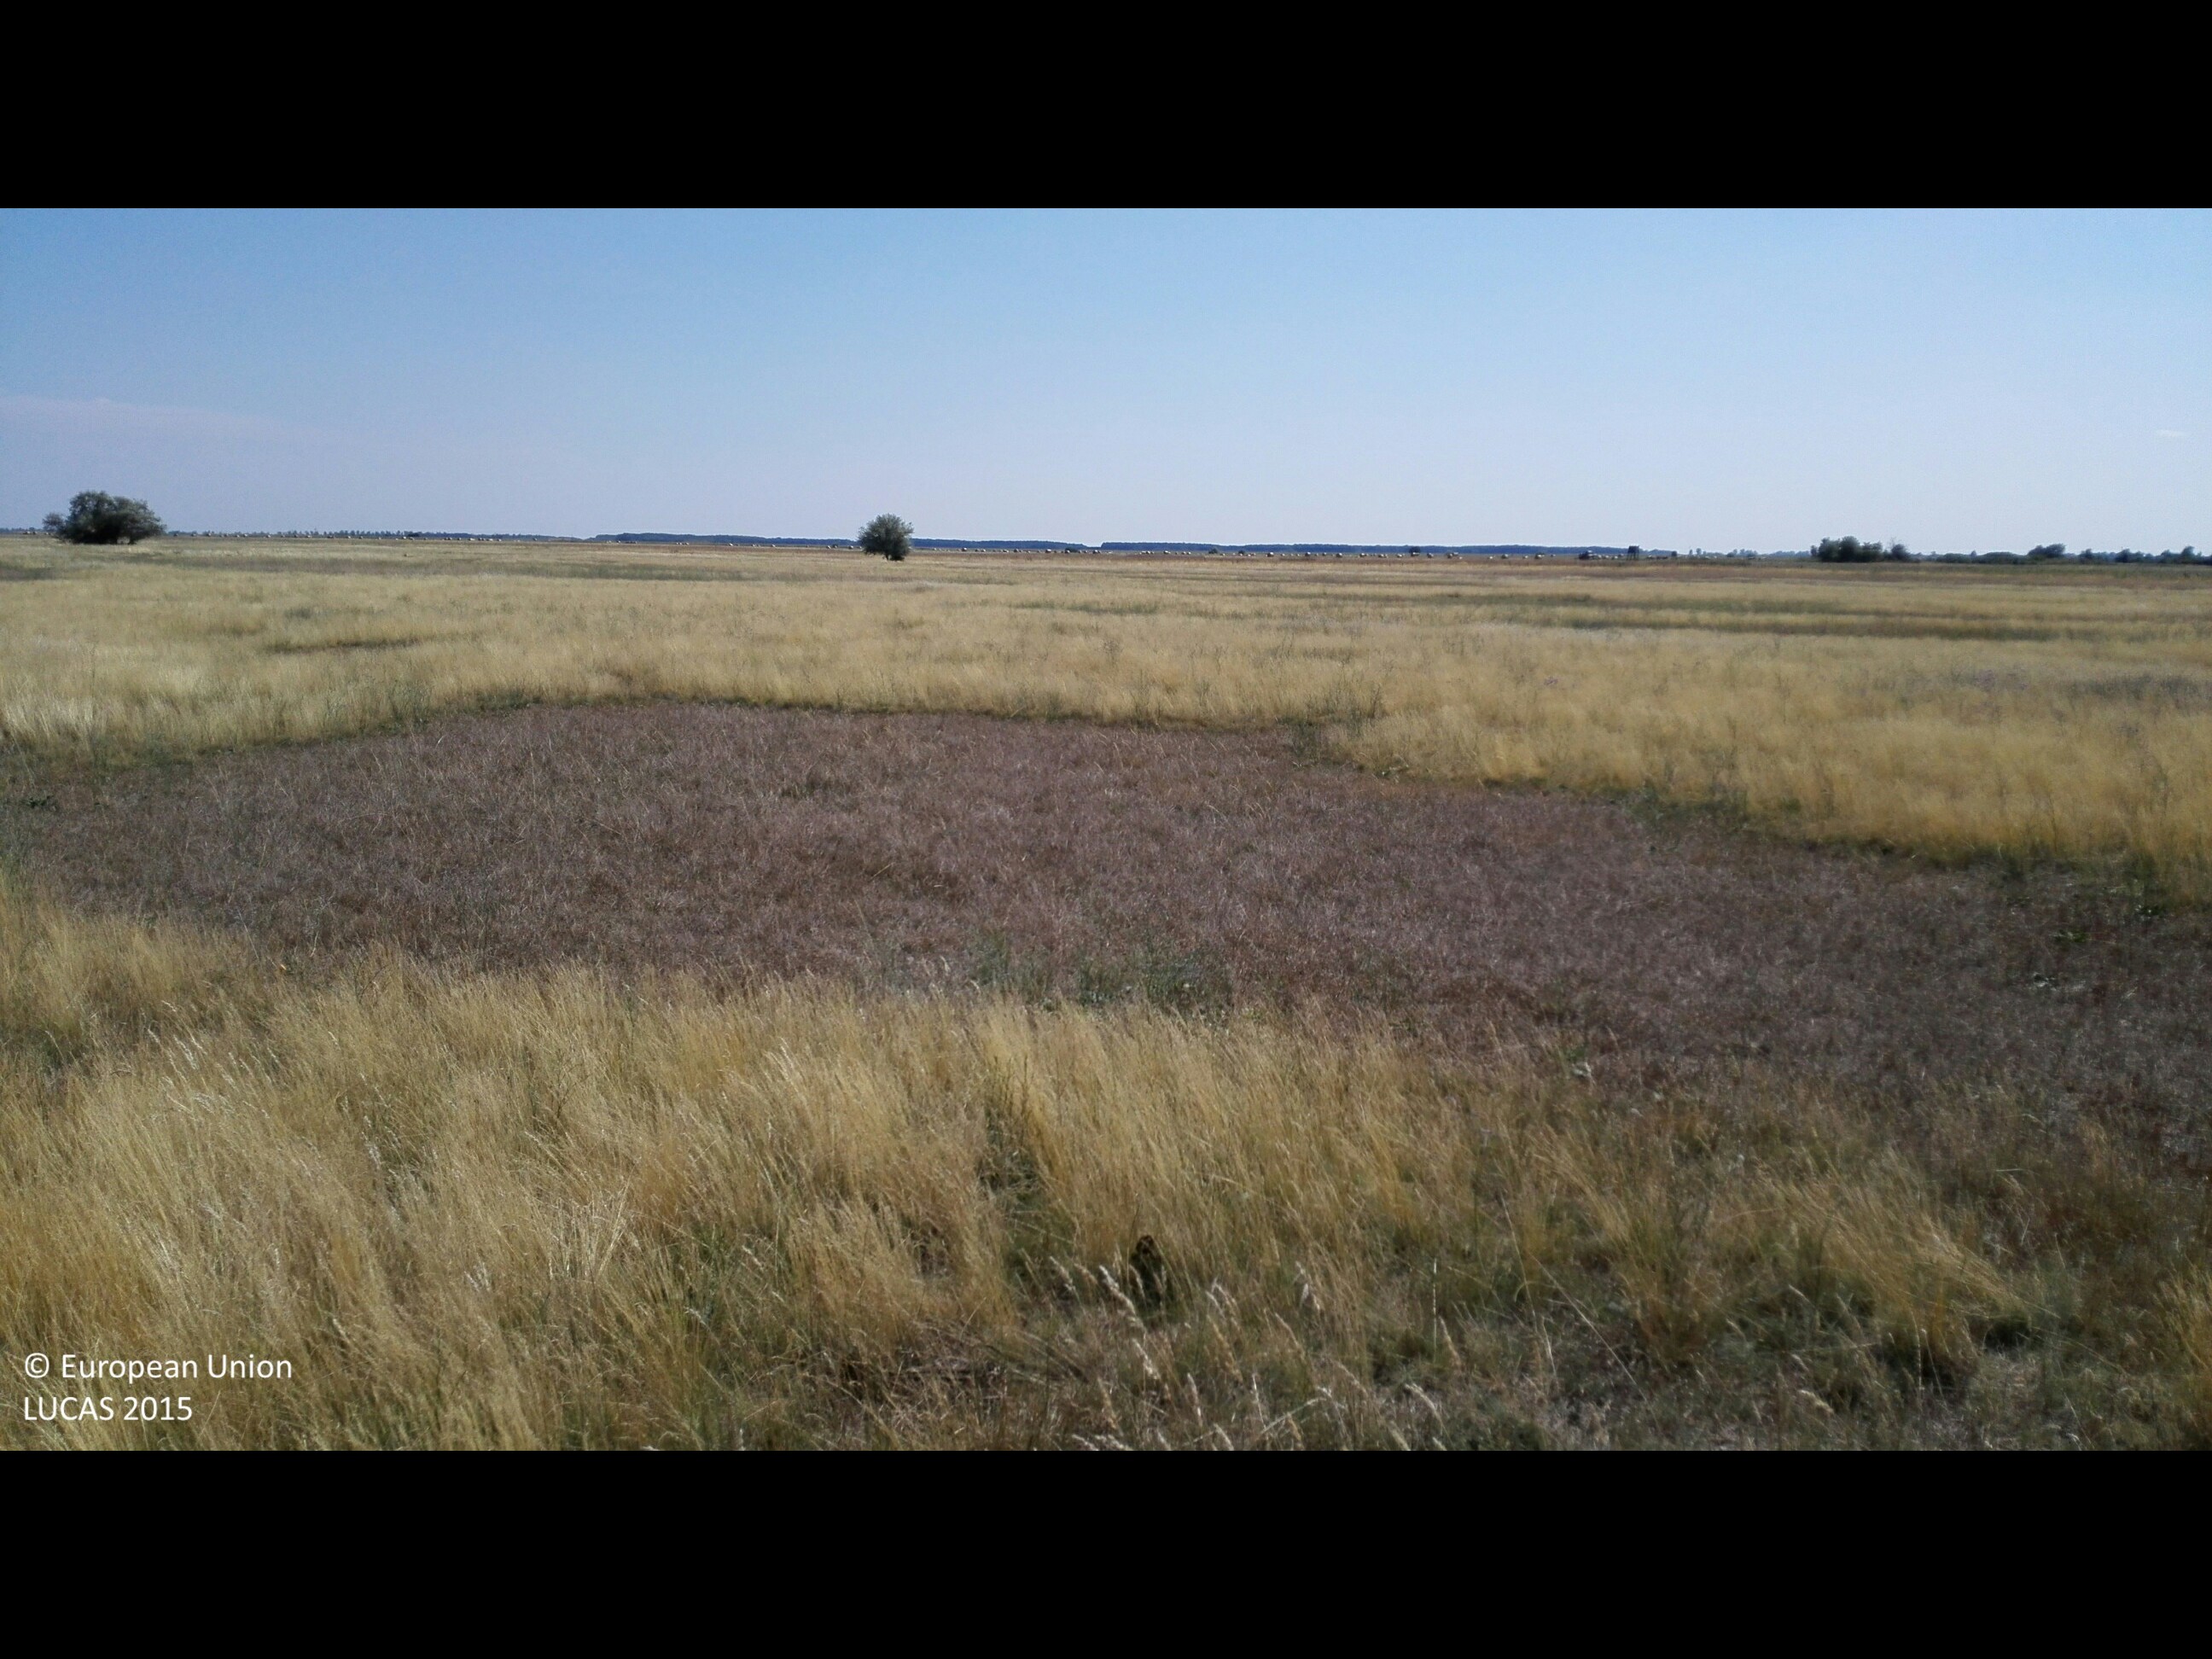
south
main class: Grassland
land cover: Grassland without tree/shrub cover
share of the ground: > 75 %
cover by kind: herbaceous plants 100 %
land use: Agriculture (excluding fallow land and kitchen gardens)
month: July
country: HU
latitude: 47.2605
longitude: 21.2852
